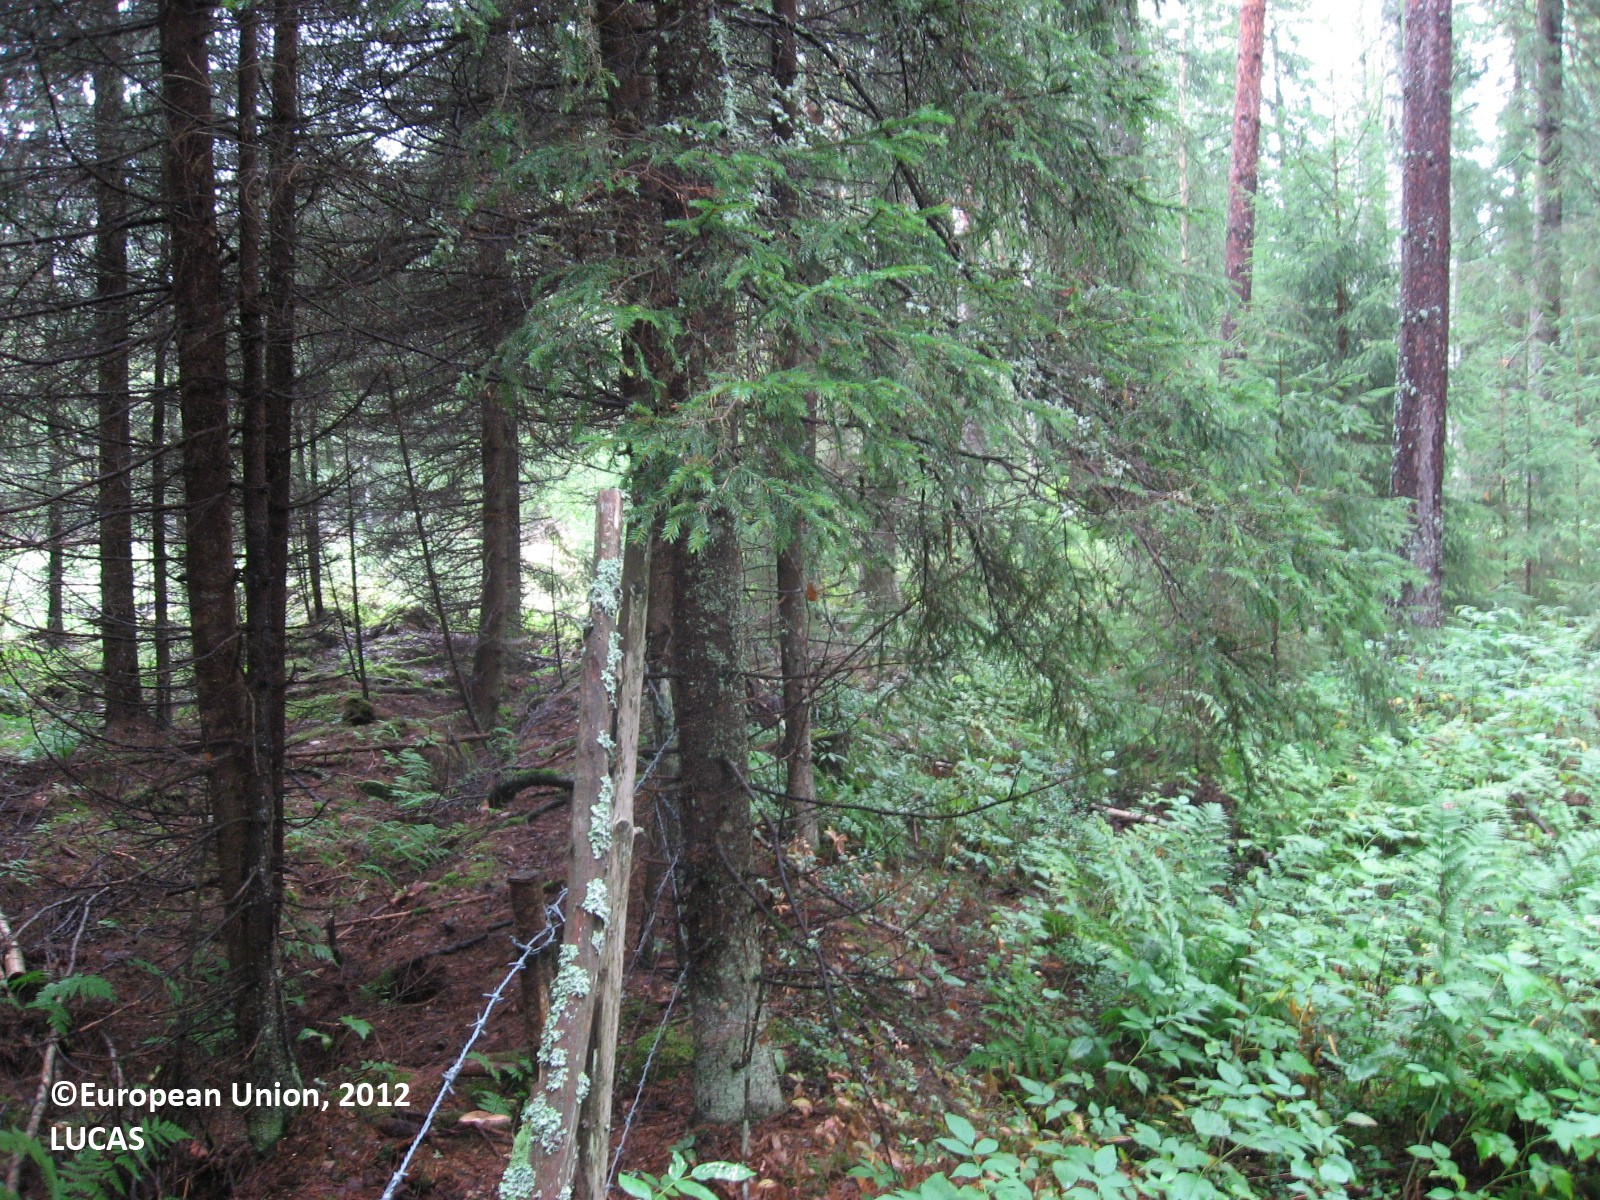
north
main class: Woodland
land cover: Spruce dominated mixed woodland
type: boreal forest
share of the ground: > 75 %
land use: Forestry
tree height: > 5 m
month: August
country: FI
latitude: 61.0692
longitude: 24.7659
